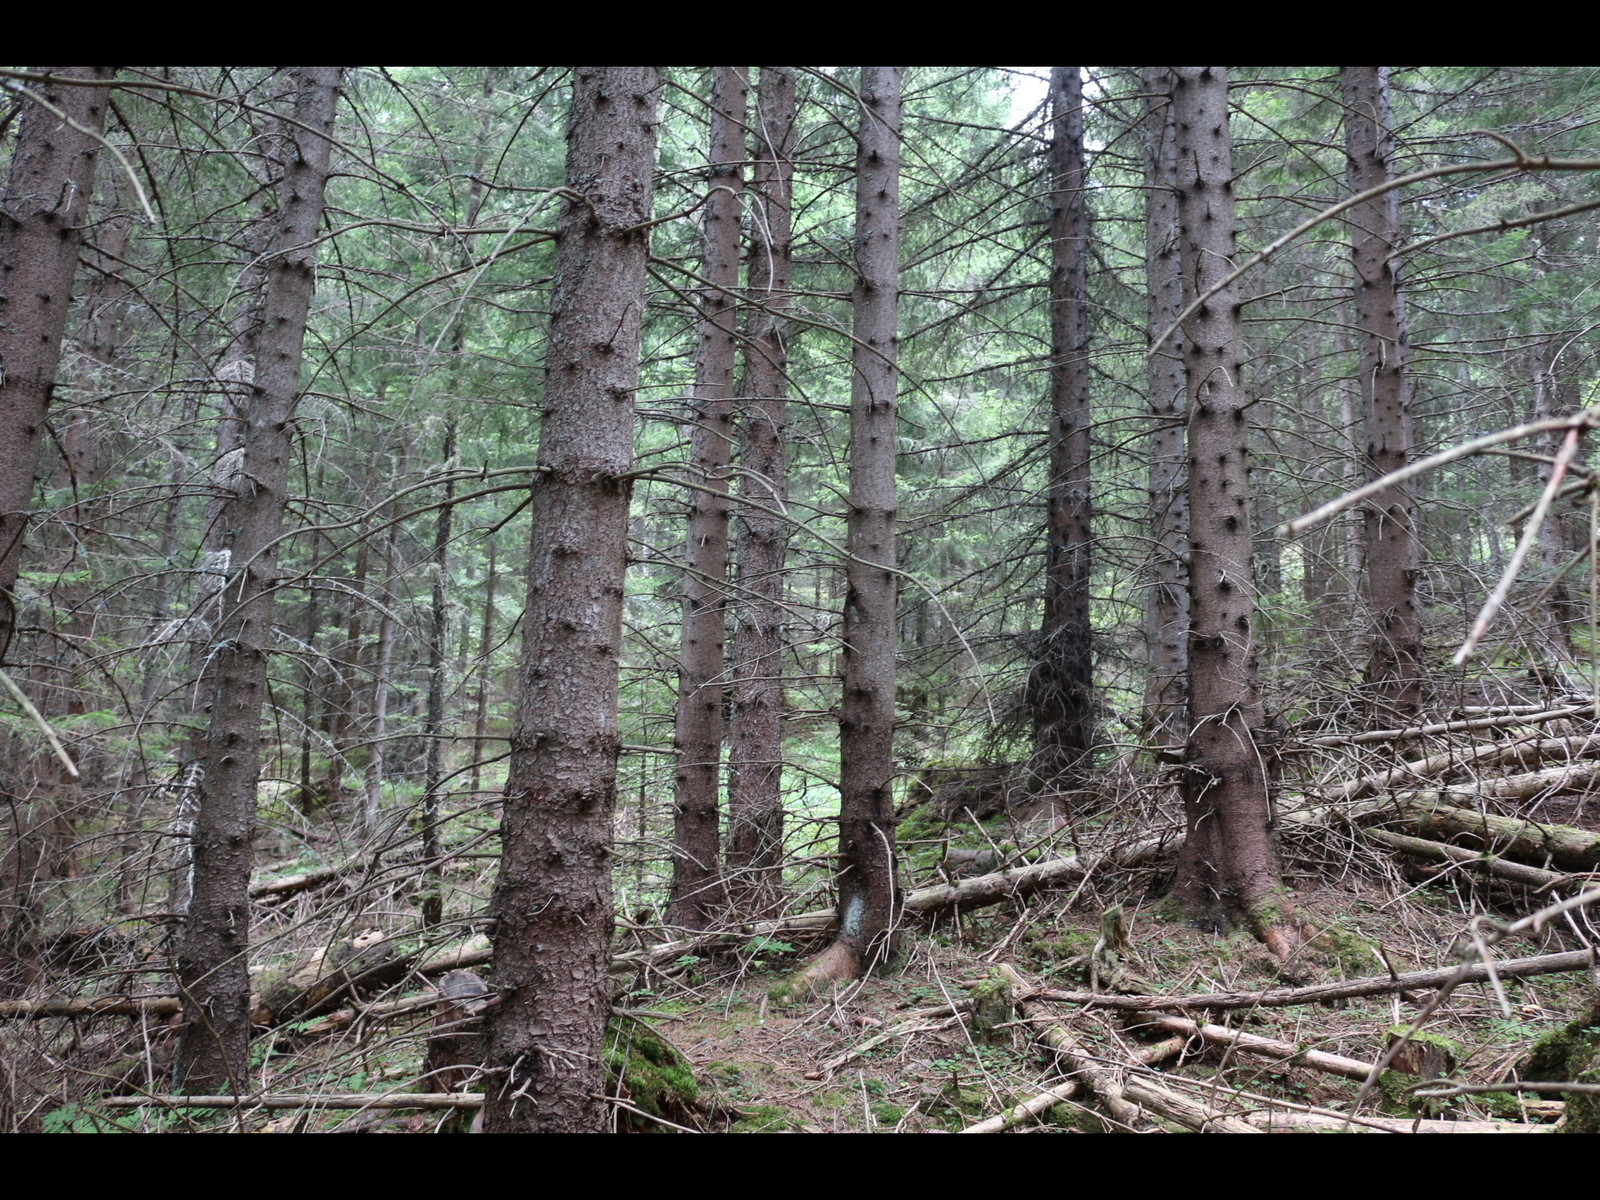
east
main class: Woodland
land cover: Spruce dominated coniferous woodland
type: alpine coniferous forest
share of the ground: > 75 %
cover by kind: coniferous forest trees 85 %, lichens and mosses 10 %, unconsolidated bare surface 5 %
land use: Forestry
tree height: > 5 m
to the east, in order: Spruce dominated coniferous woodland; Tracks; Spruce dominated coniferous woodland; Grass margins; Tracks; Grass margins; Spruce dominated coniferous woodland; Spontaneously vegetated surfaces; Spruce dominated coniferous woodland; Rivers and streams; Spruce dominated coniferous woodland; Spontaneously vegetated surfaces; Tracks; Spruce dominated coniferous woodland
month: August
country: AT
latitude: 46.9414
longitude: 14.0571
